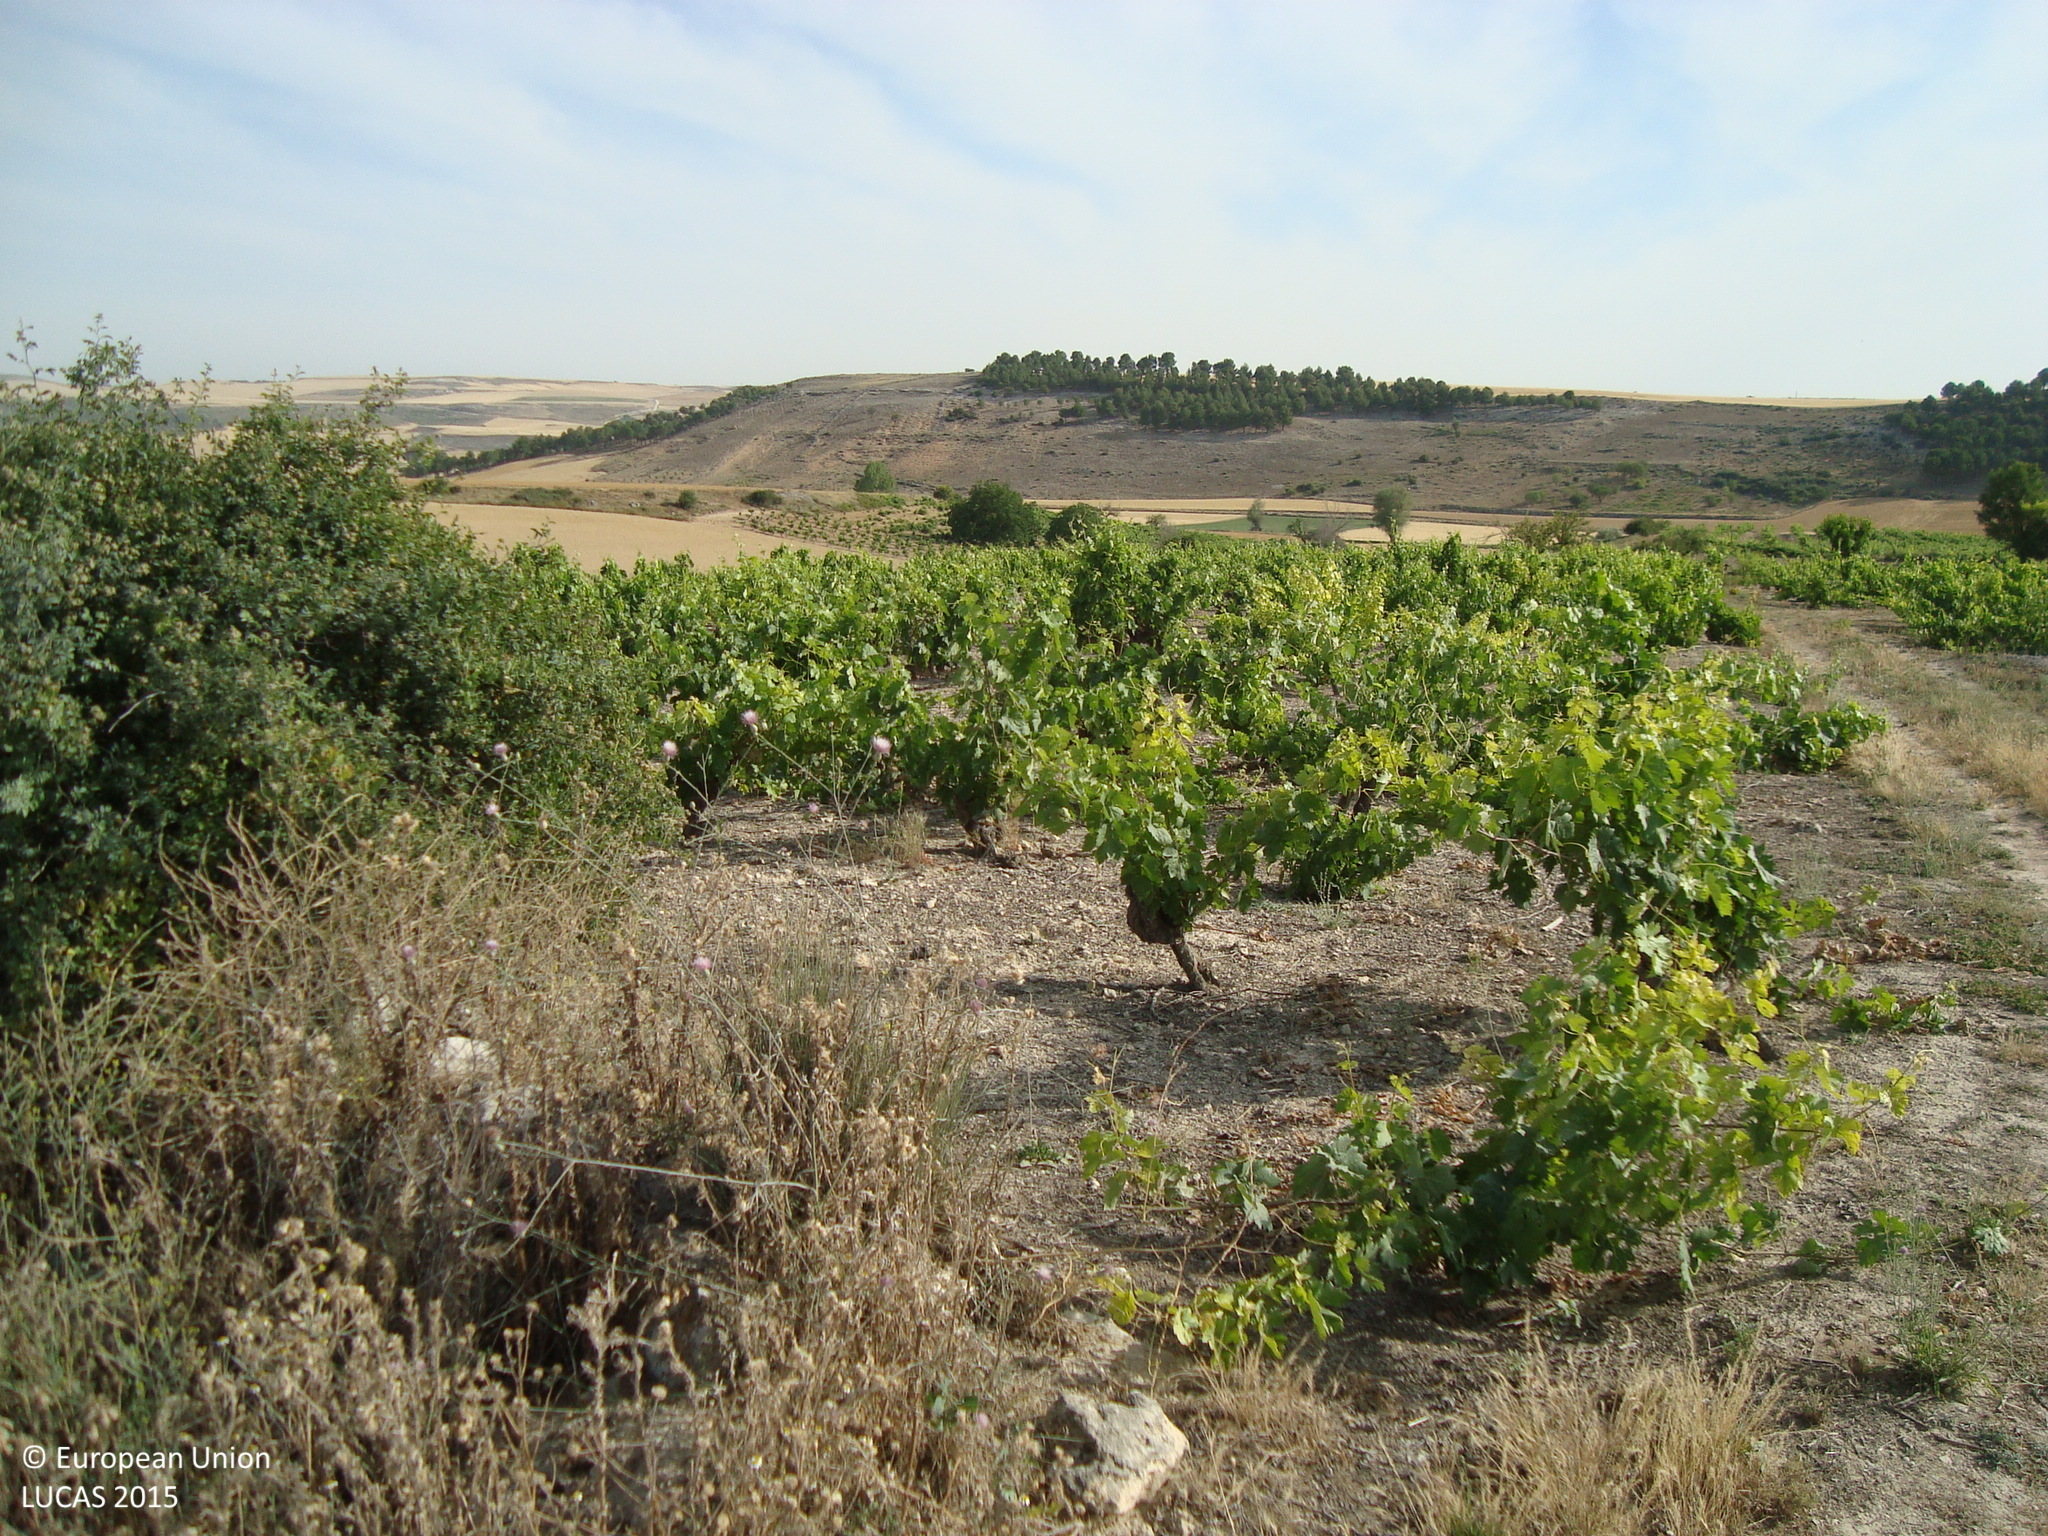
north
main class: Cropland
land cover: Vineyards
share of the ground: 50 - 75 %
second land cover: Other bare soil
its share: > 75 %
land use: Agriculture (excluding fallow land and kitchen gardens)
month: July
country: ES
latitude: 41.7341
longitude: -4.2369
